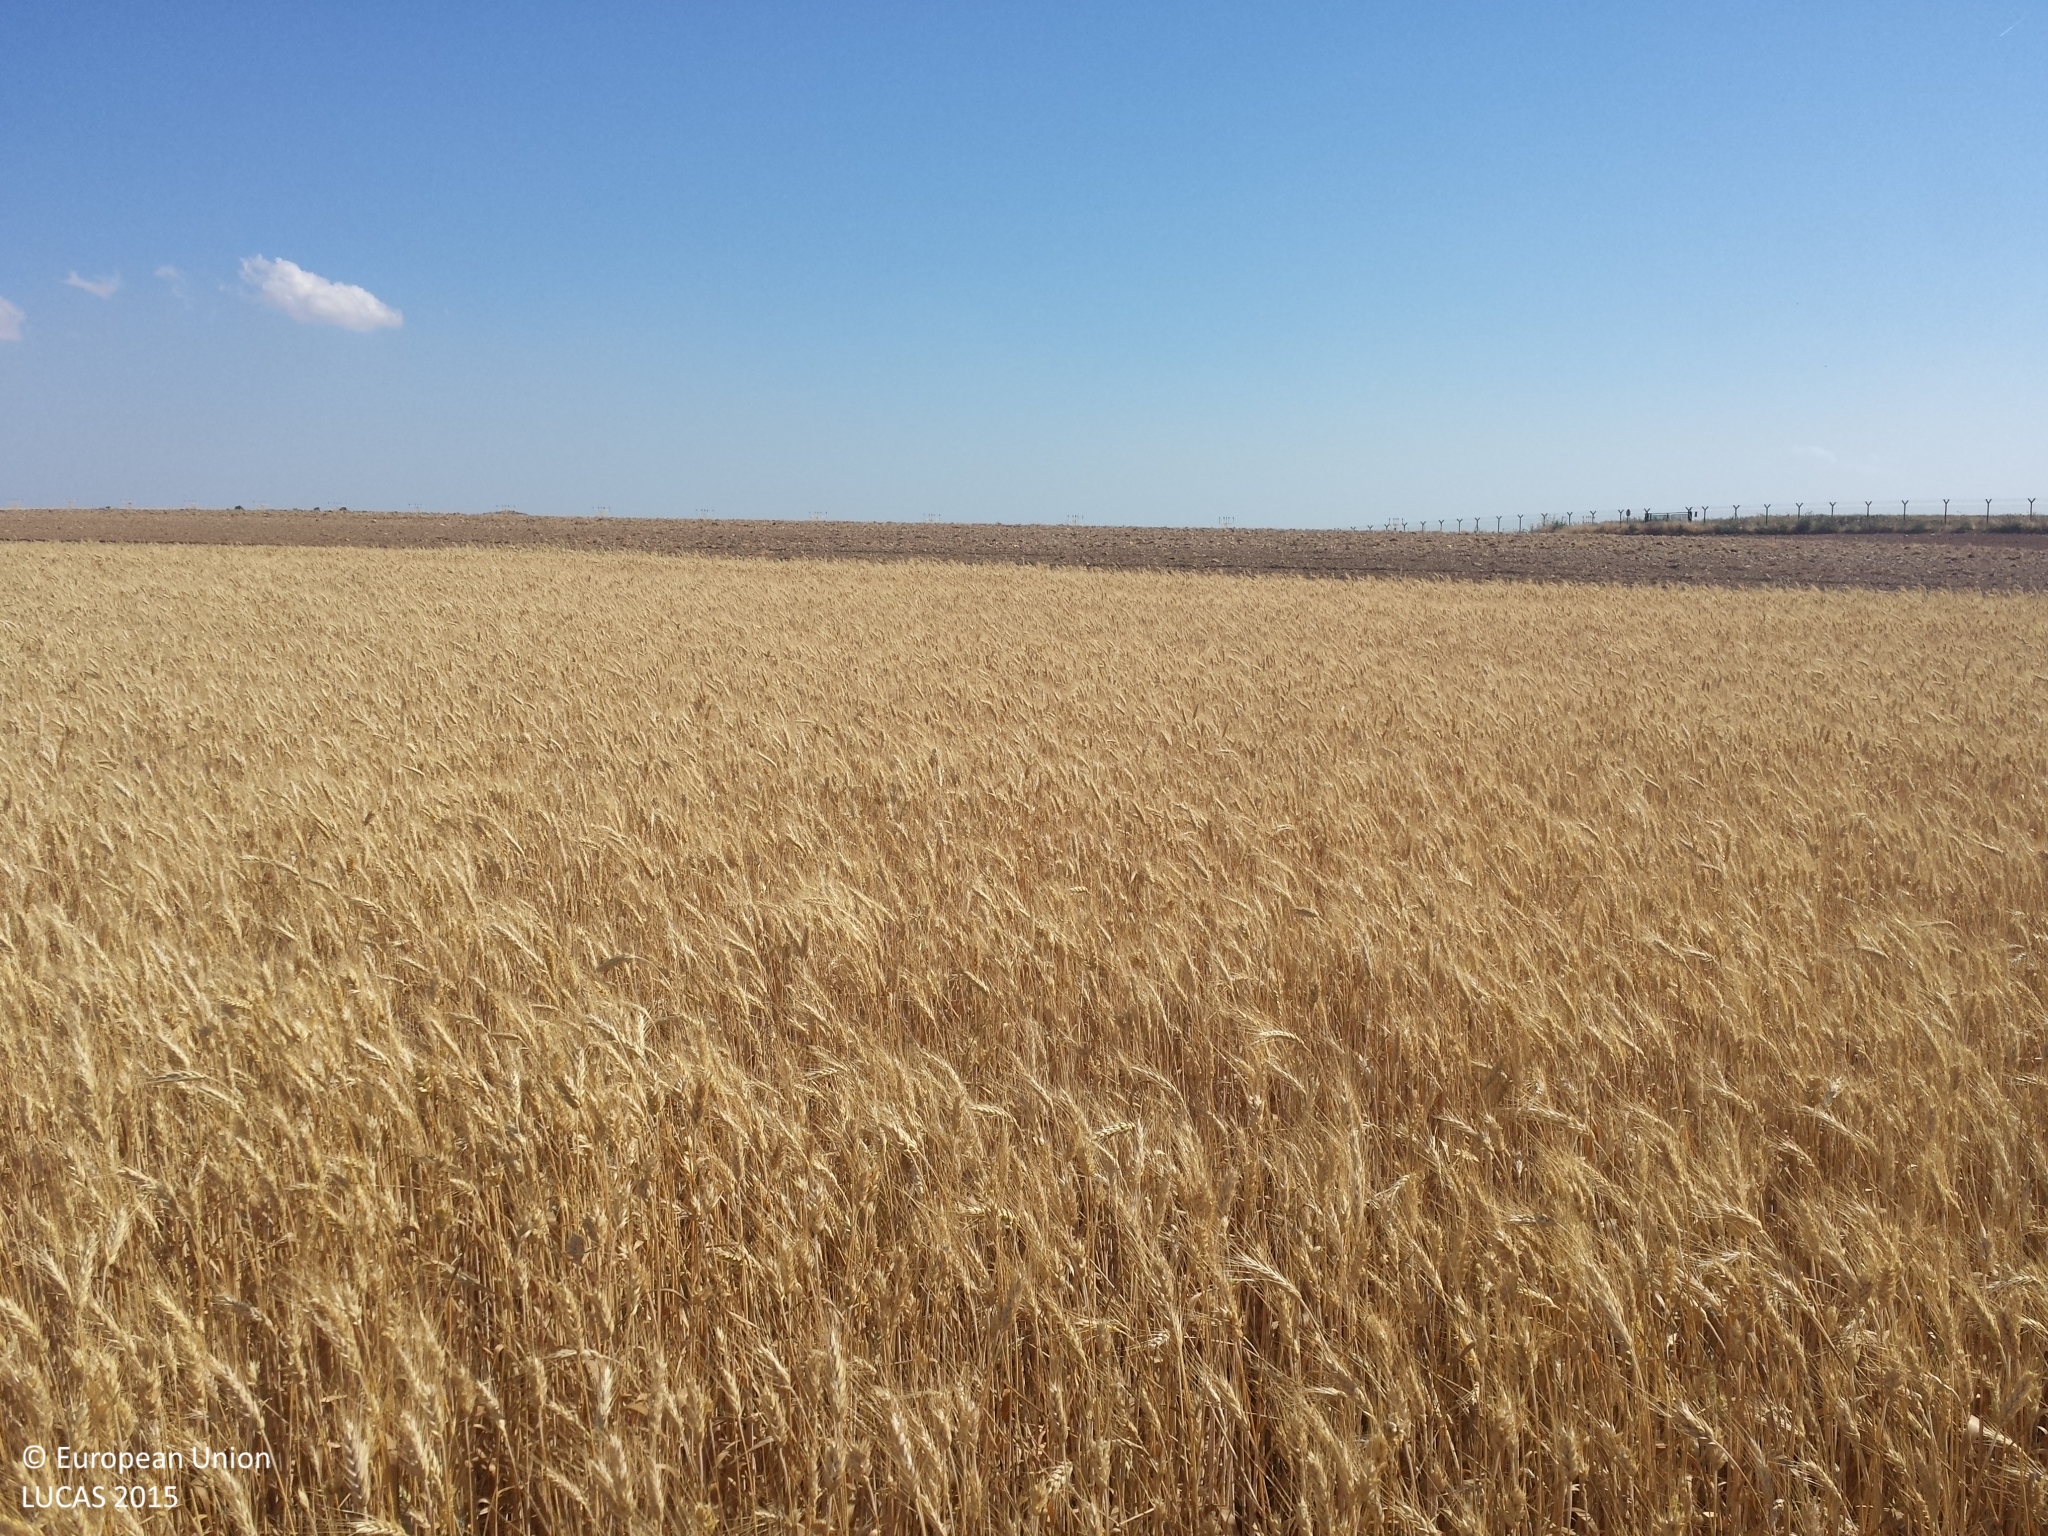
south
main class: Cropland
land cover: Common wheat
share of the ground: > 75 %
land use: Agriculture (excluding fallow land and kitchen gardens)
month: May
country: ES
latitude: 41.7206
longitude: 0.5505
